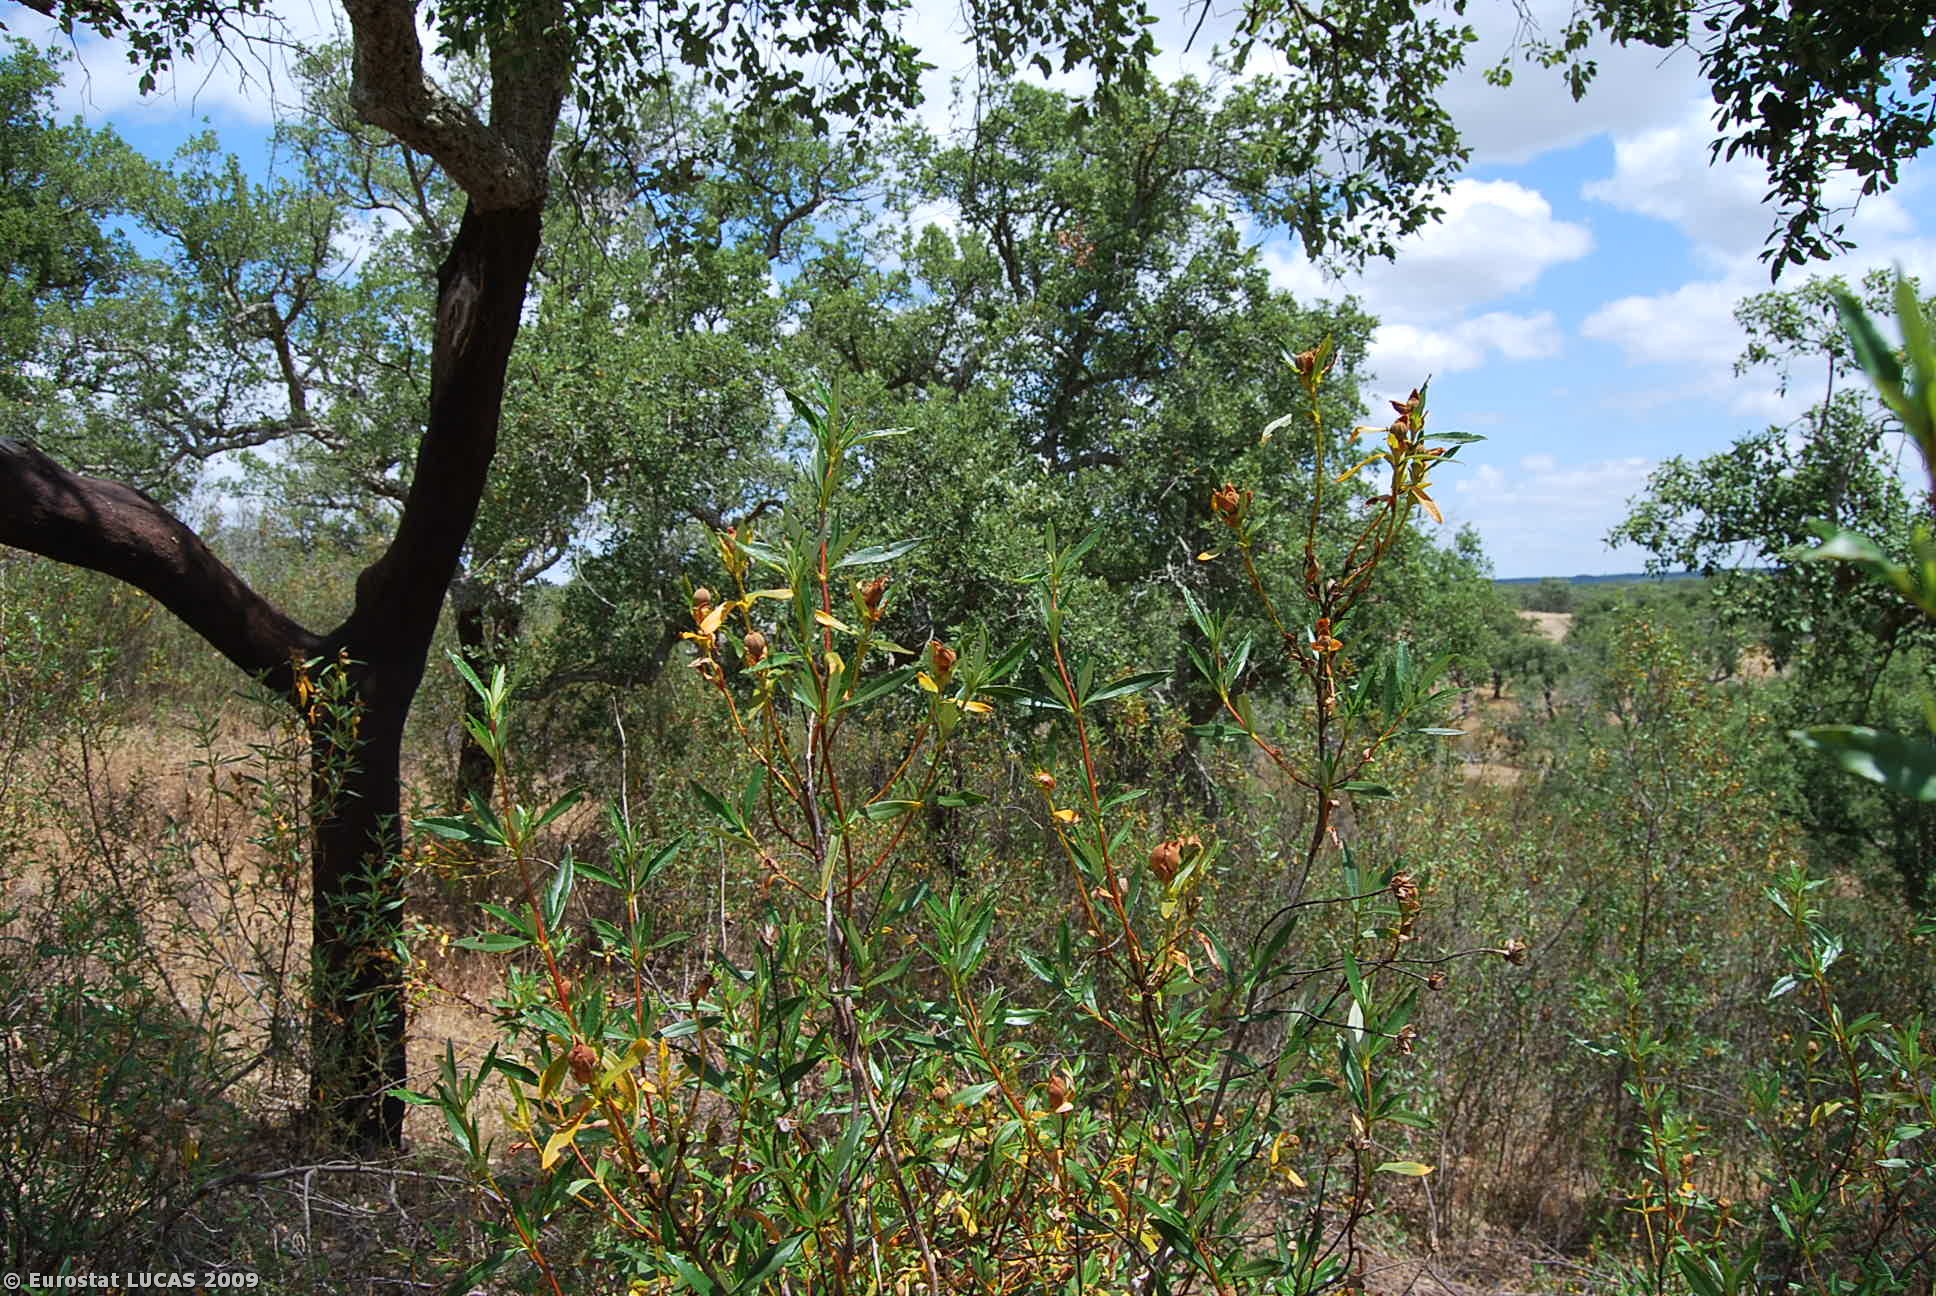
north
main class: Woodland
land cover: Broadleaved woodland
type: broadleaved evergreen forest
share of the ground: 10 - 25 %
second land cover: Shrubland with sparse tree cover
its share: 50 - 75 %
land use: Forestry
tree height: > 5 m
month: June
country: PT
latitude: 38.0082
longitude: -8.5988
